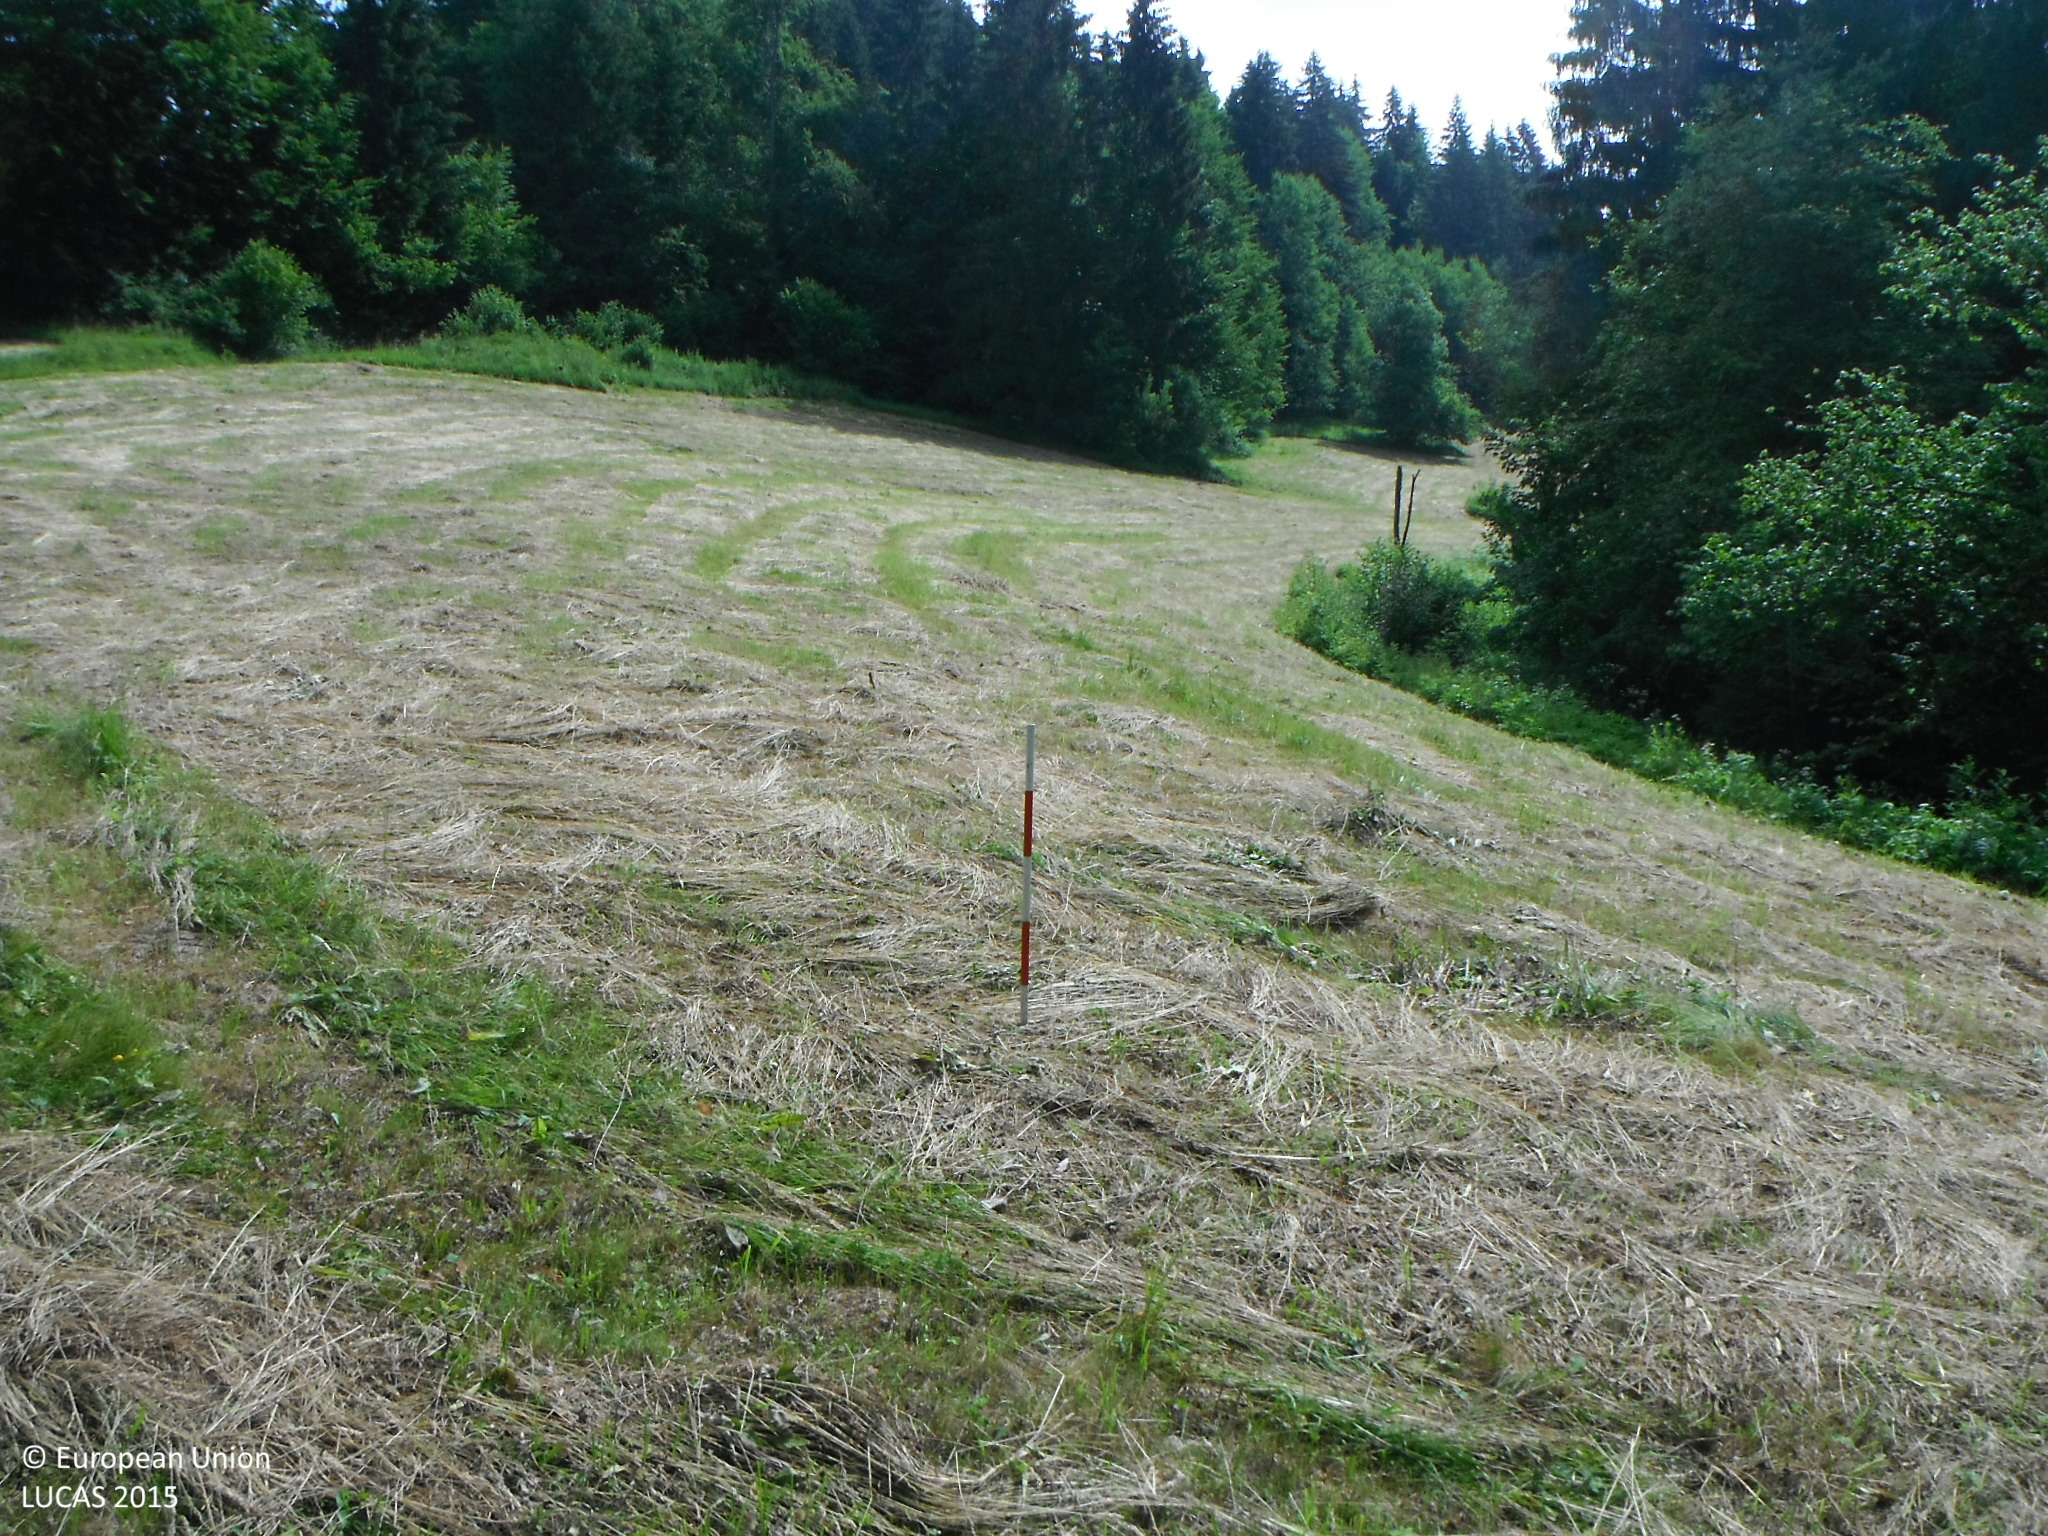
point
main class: Grassland
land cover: Grassland without tree/shrub cover
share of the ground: > 75 %
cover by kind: herbaceous plants 100 %
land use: Agriculture (excluding fallow land and kitchen gardens)
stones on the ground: < 10 %
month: June
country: SK
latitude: 49.2356
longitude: 19.3780
